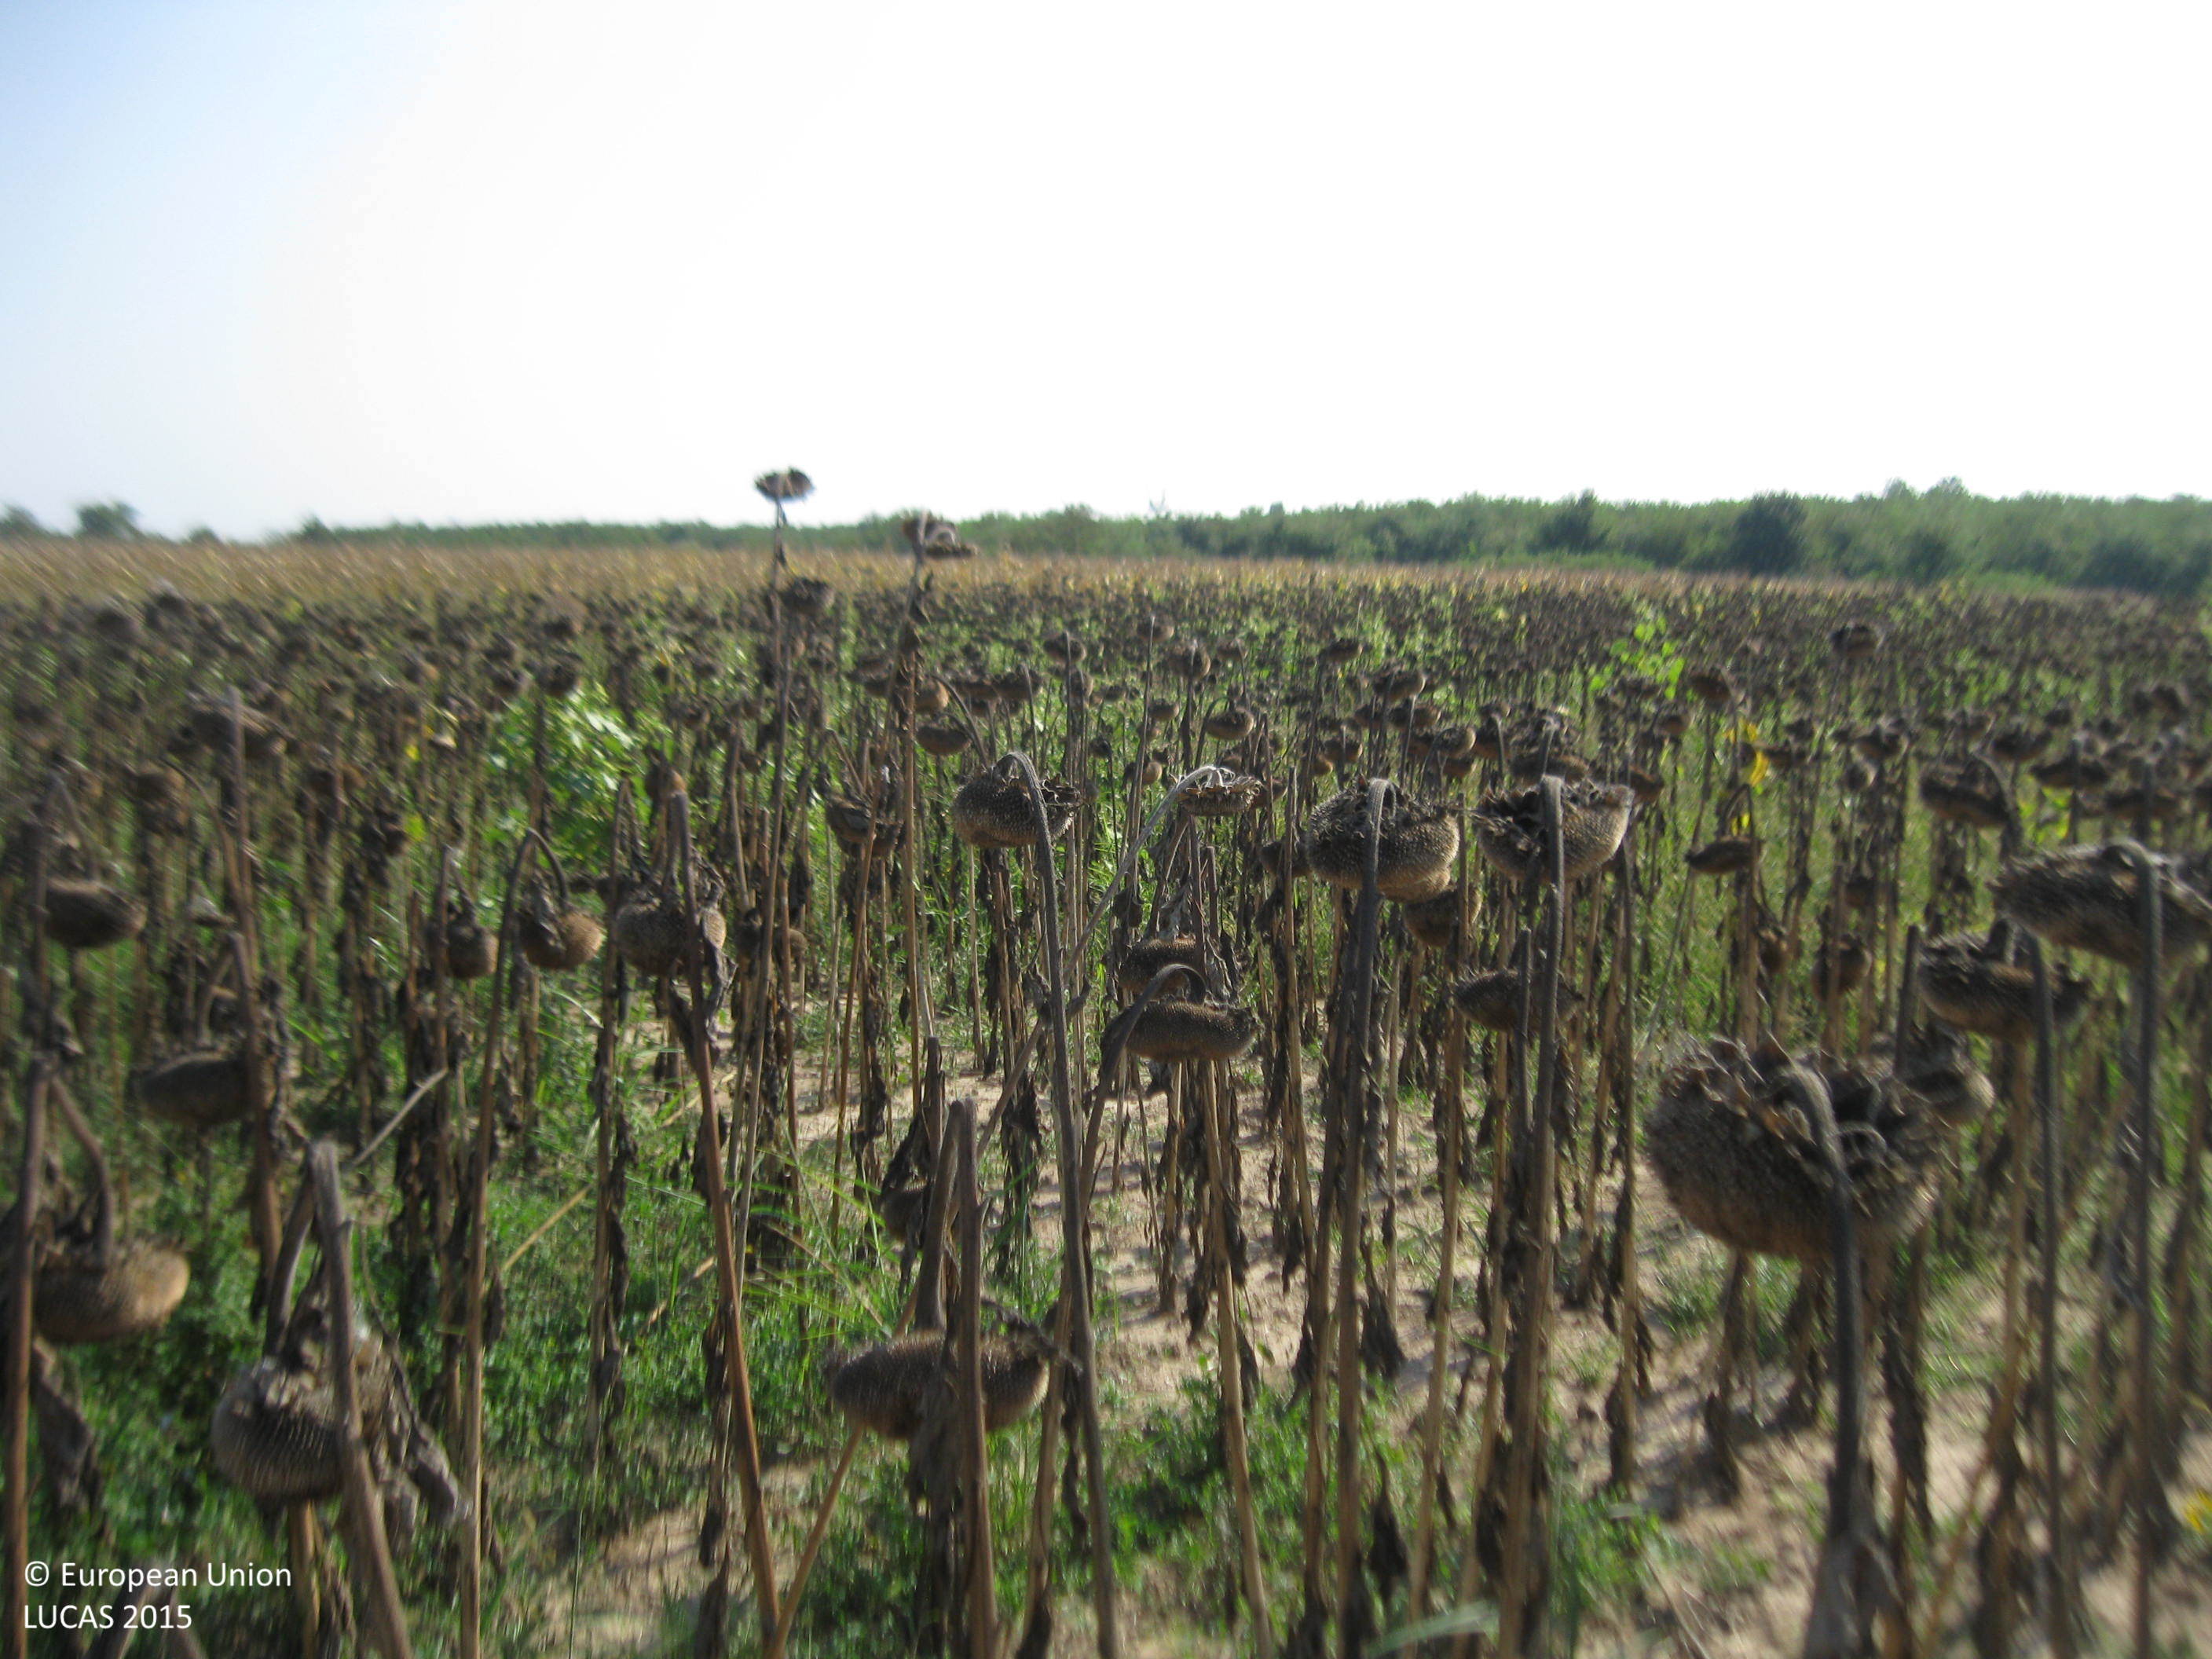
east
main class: Cropland
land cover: Sunflower
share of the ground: > 75 %
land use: Agriculture (excluding fallow land and kitchen gardens)
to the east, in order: Sunflower; Grass margins; Maize; Grassland with sparse tree/shrub cover; Tracks; Broadleaved woodland
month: September
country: BG
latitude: 42.2624
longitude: 25.0049
